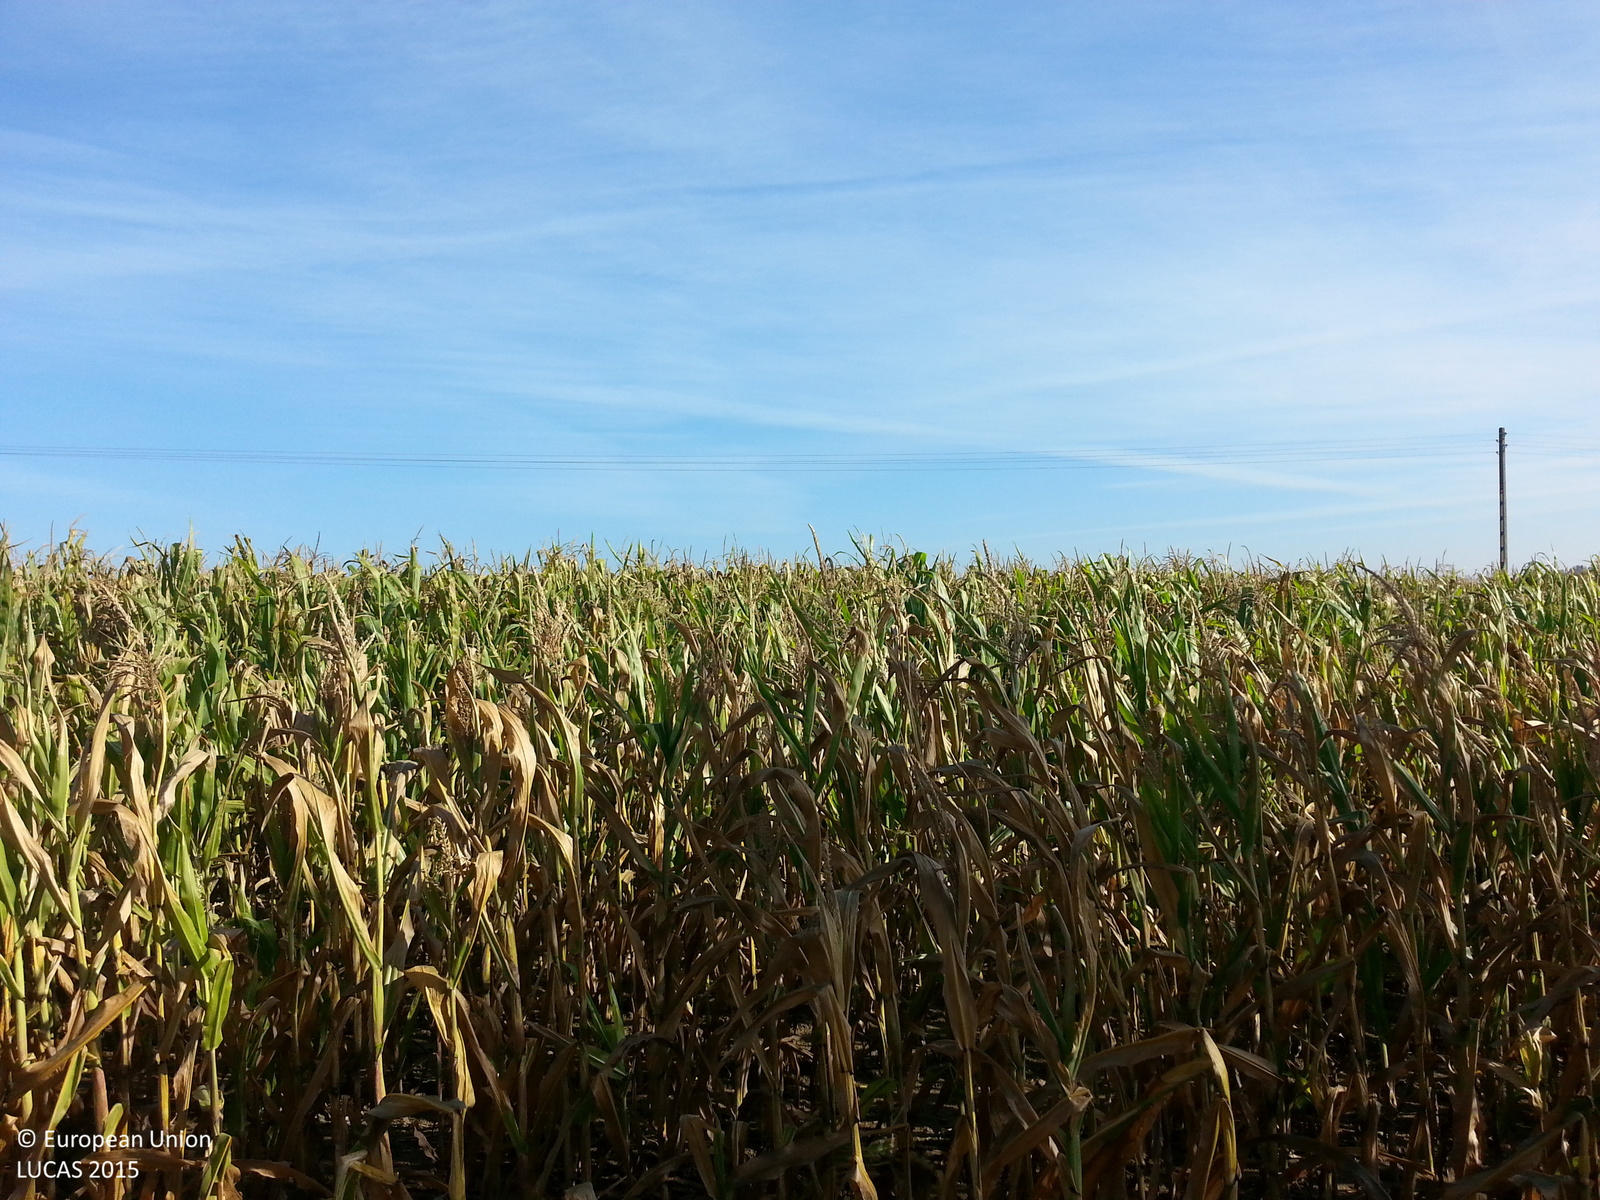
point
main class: Cropland
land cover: Maize
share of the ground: > 75 %
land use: Agriculture (excluding fallow land and kitchen gardens)
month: September
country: PL
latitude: 53.1247
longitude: 19.1847
